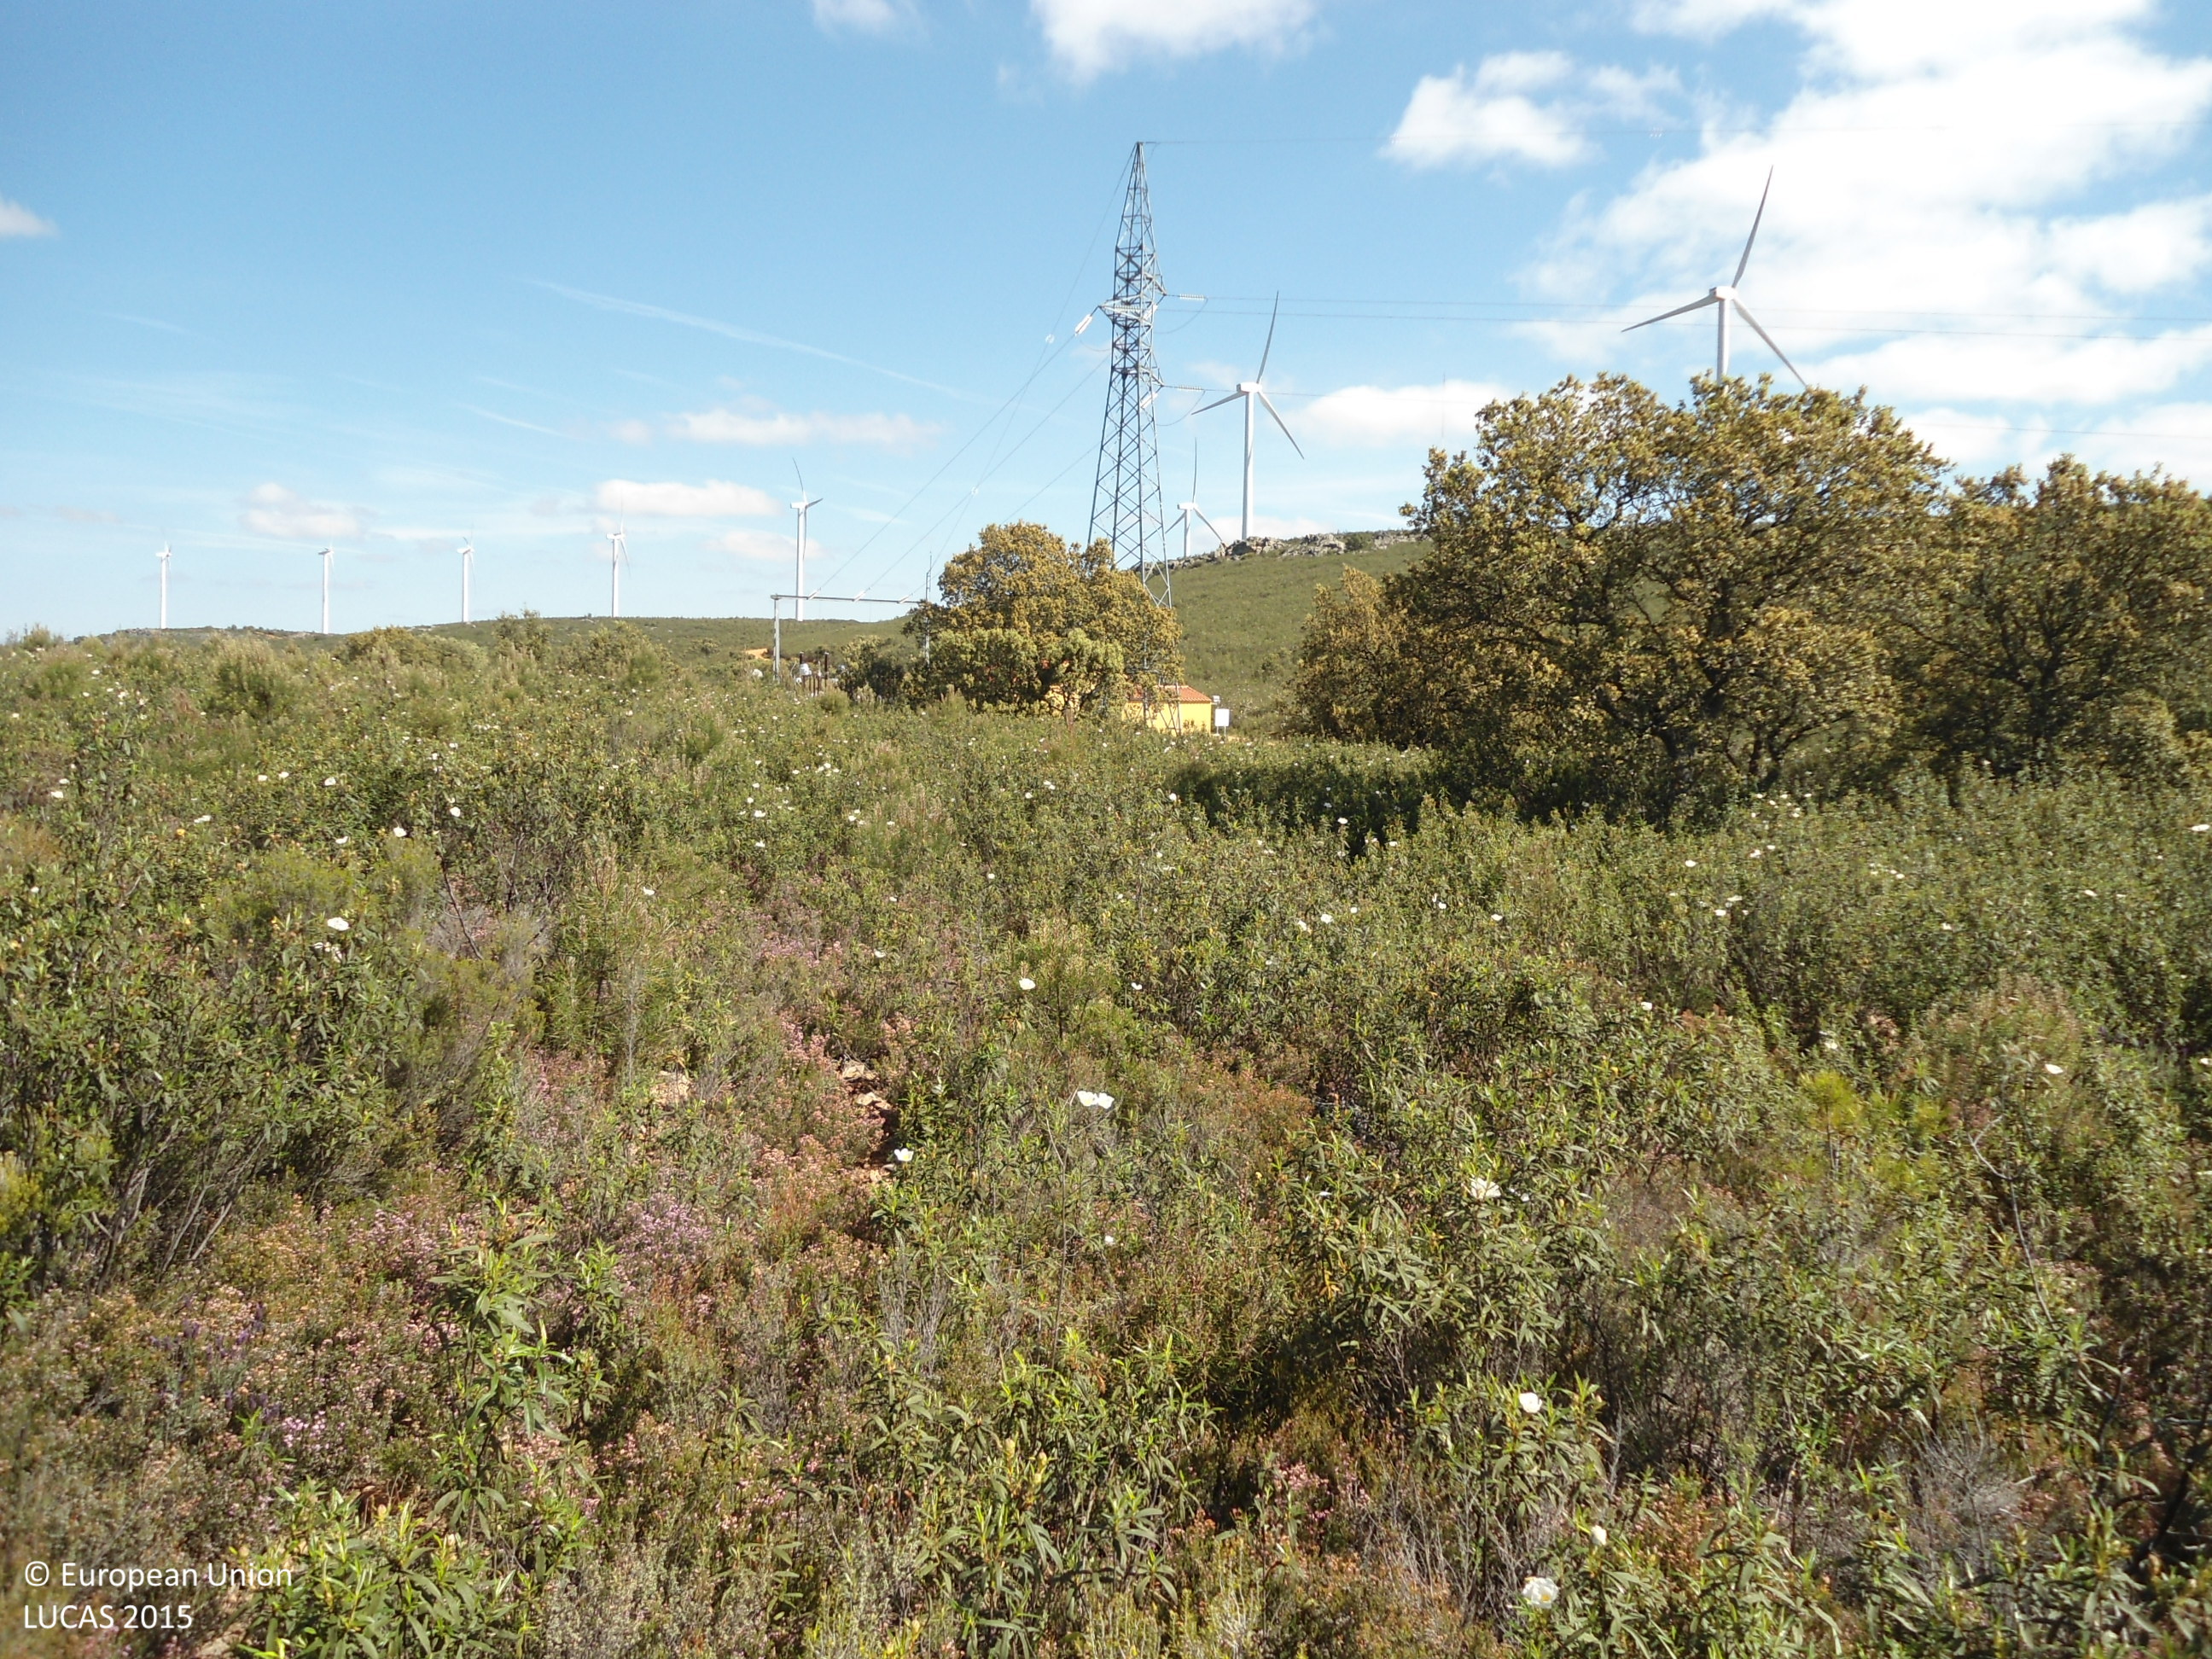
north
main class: Shrubland
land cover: Shrubland without tree cover
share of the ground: > 75 %
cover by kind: shrubs 100 %
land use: Semi-natural and natural areas not in use
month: May
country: ES
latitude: 41.8643
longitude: -5.9129
